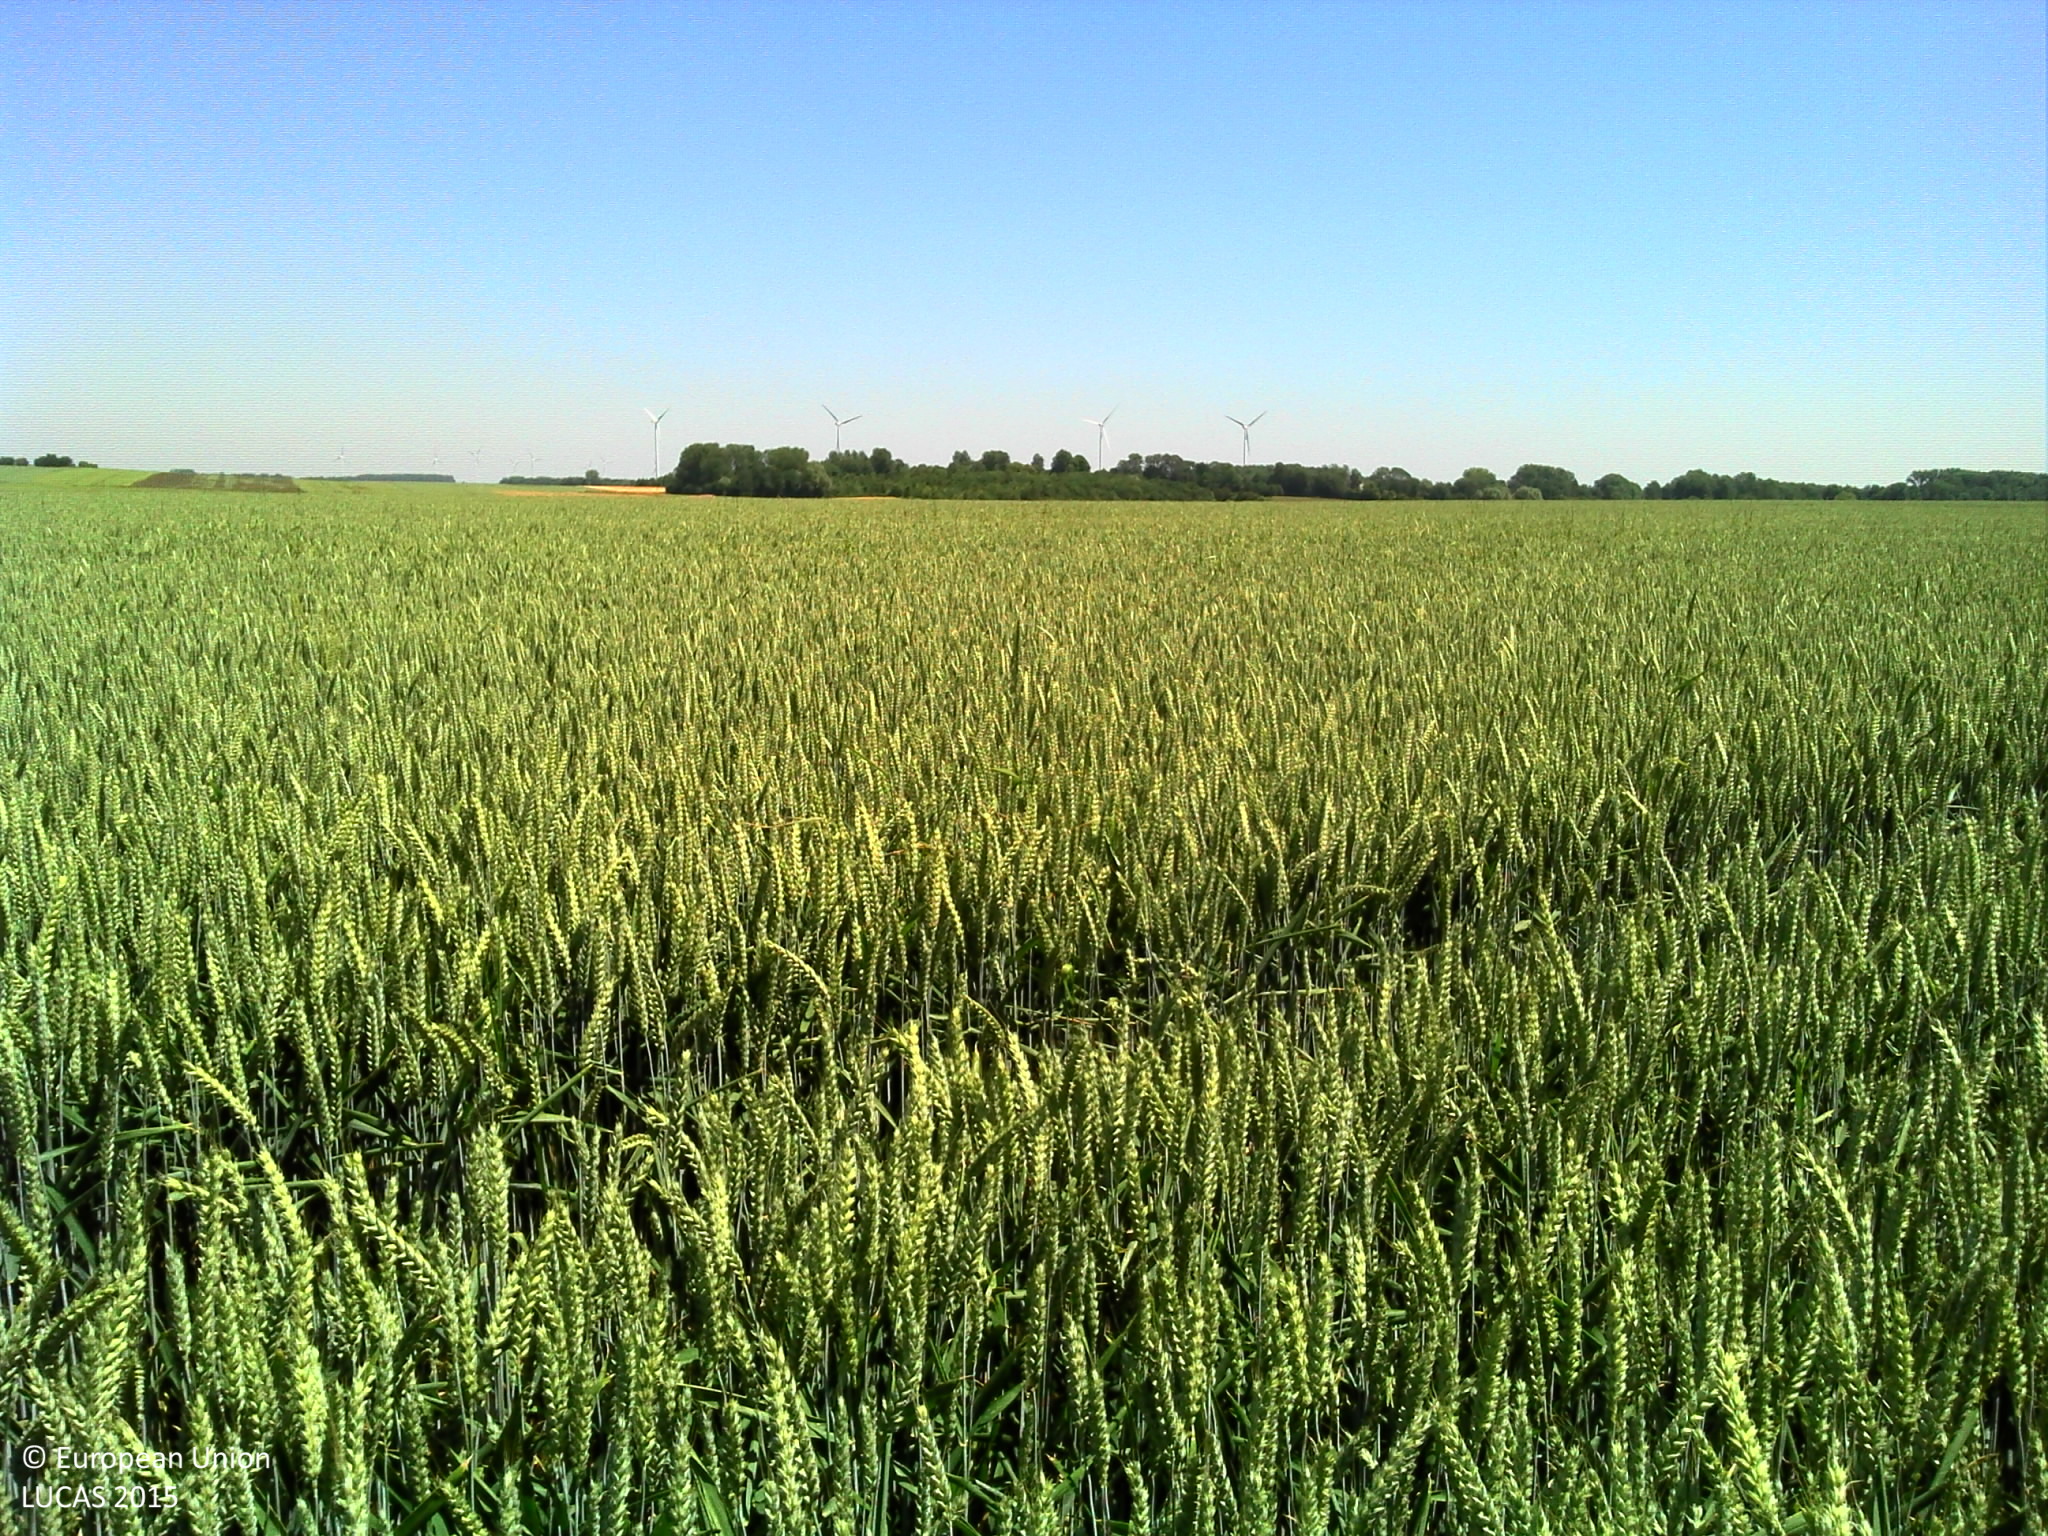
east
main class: Cropland
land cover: Common wheat
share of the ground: > 75 %
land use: Agriculture (excluding fallow land and kitchen gardens)
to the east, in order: Common wheat; Electric lines; Common wheat
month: June
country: FR
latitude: 50.3269
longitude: 2.3874
